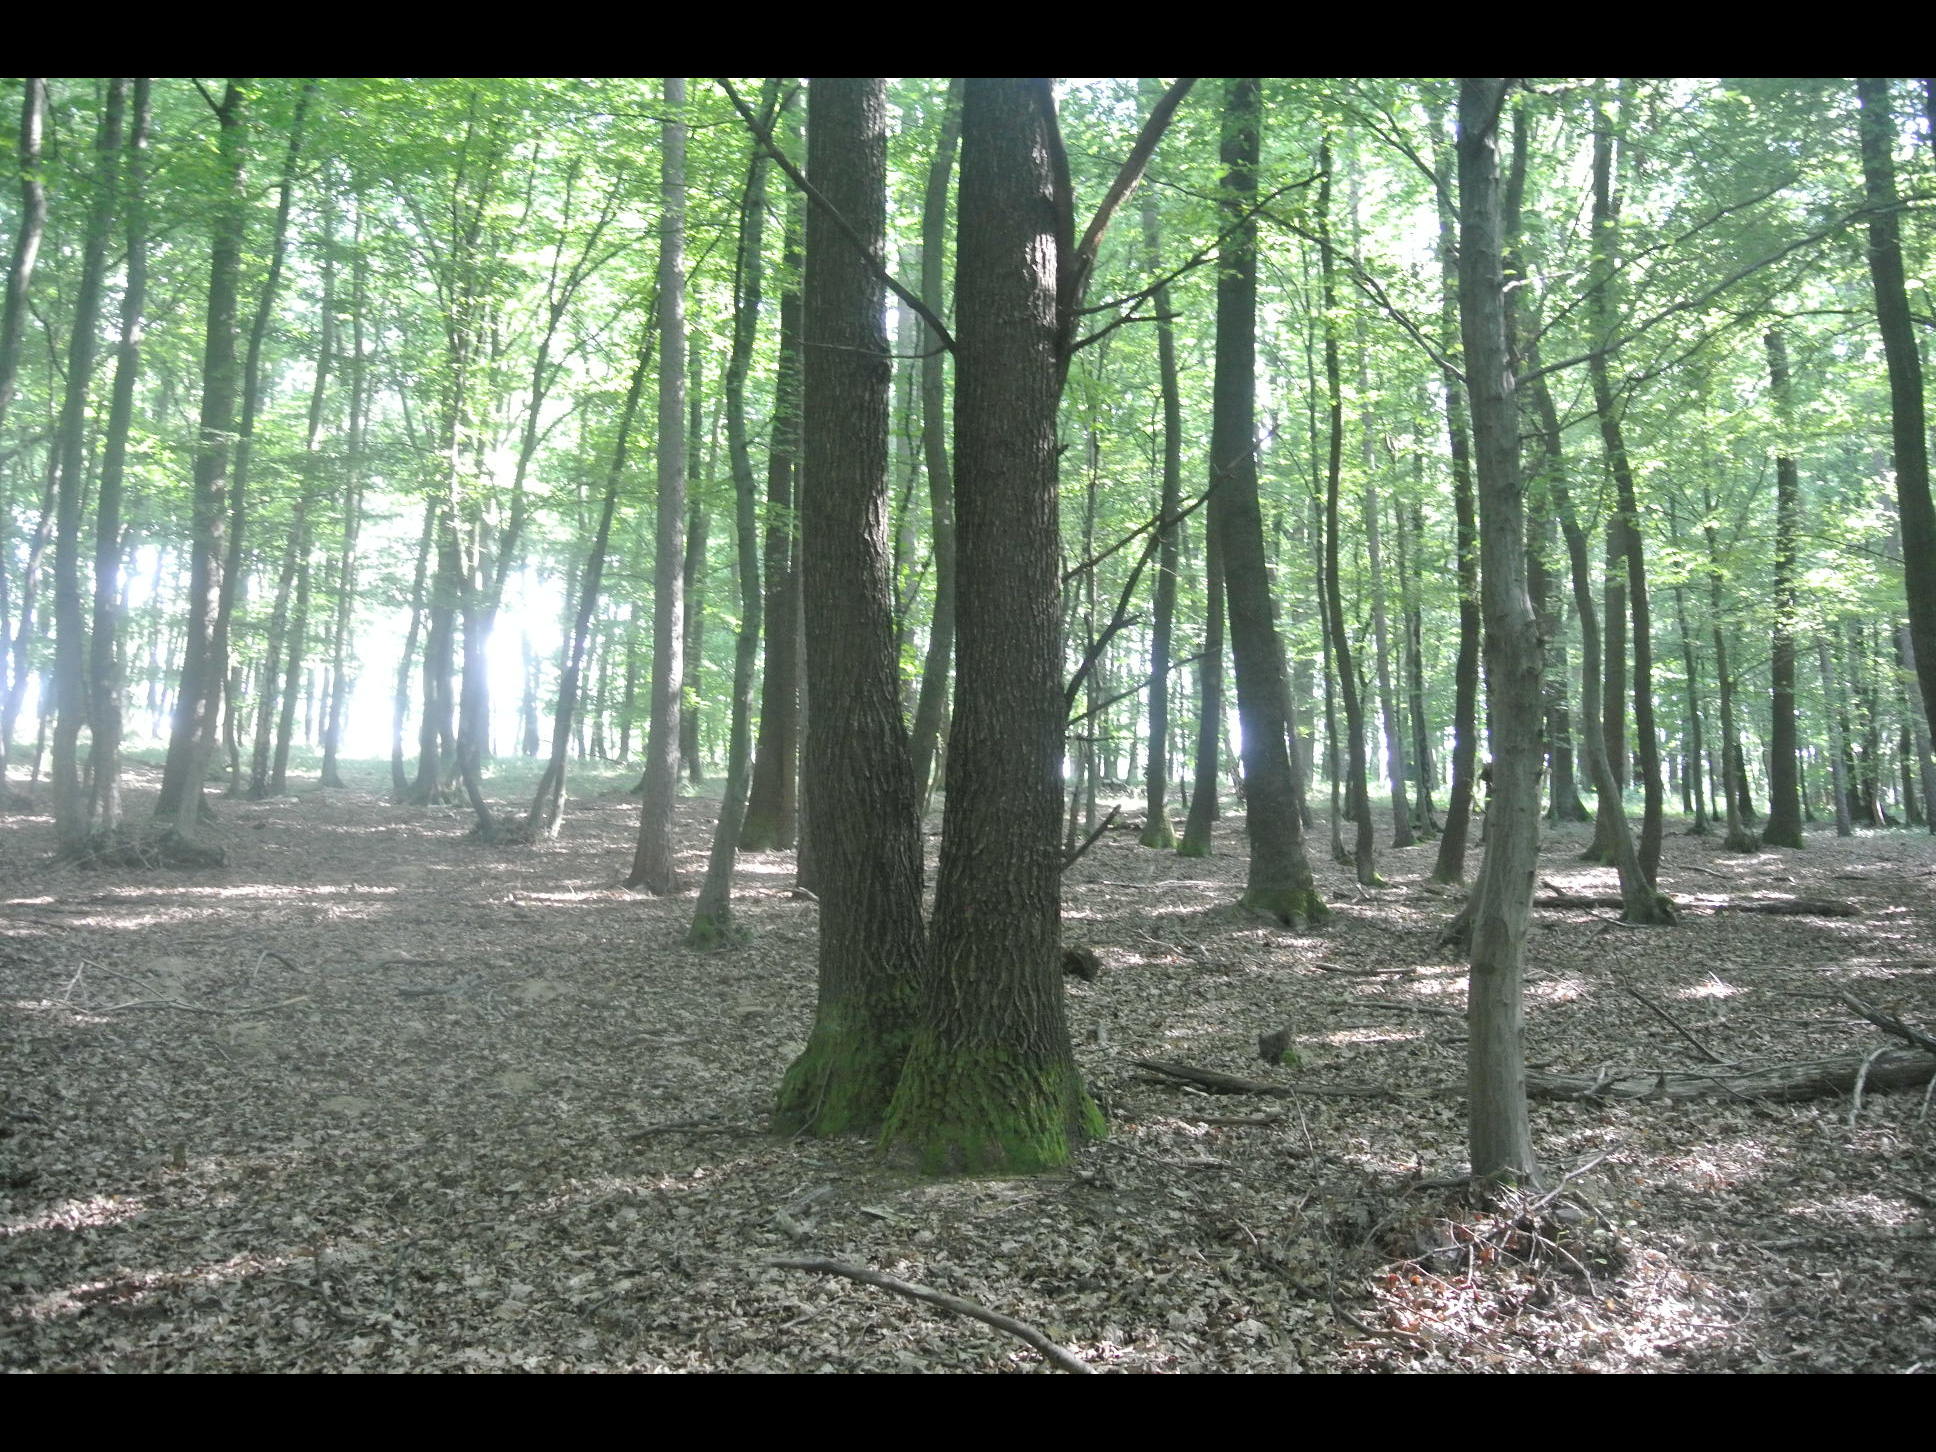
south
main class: Woodland
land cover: Broadleaved woodland
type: beech forest
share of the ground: > 75 %
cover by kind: broadleaved forest trees 100 %
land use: Forestry
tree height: > 5 m
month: July
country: AT
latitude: 47.4156
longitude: 16.5380
